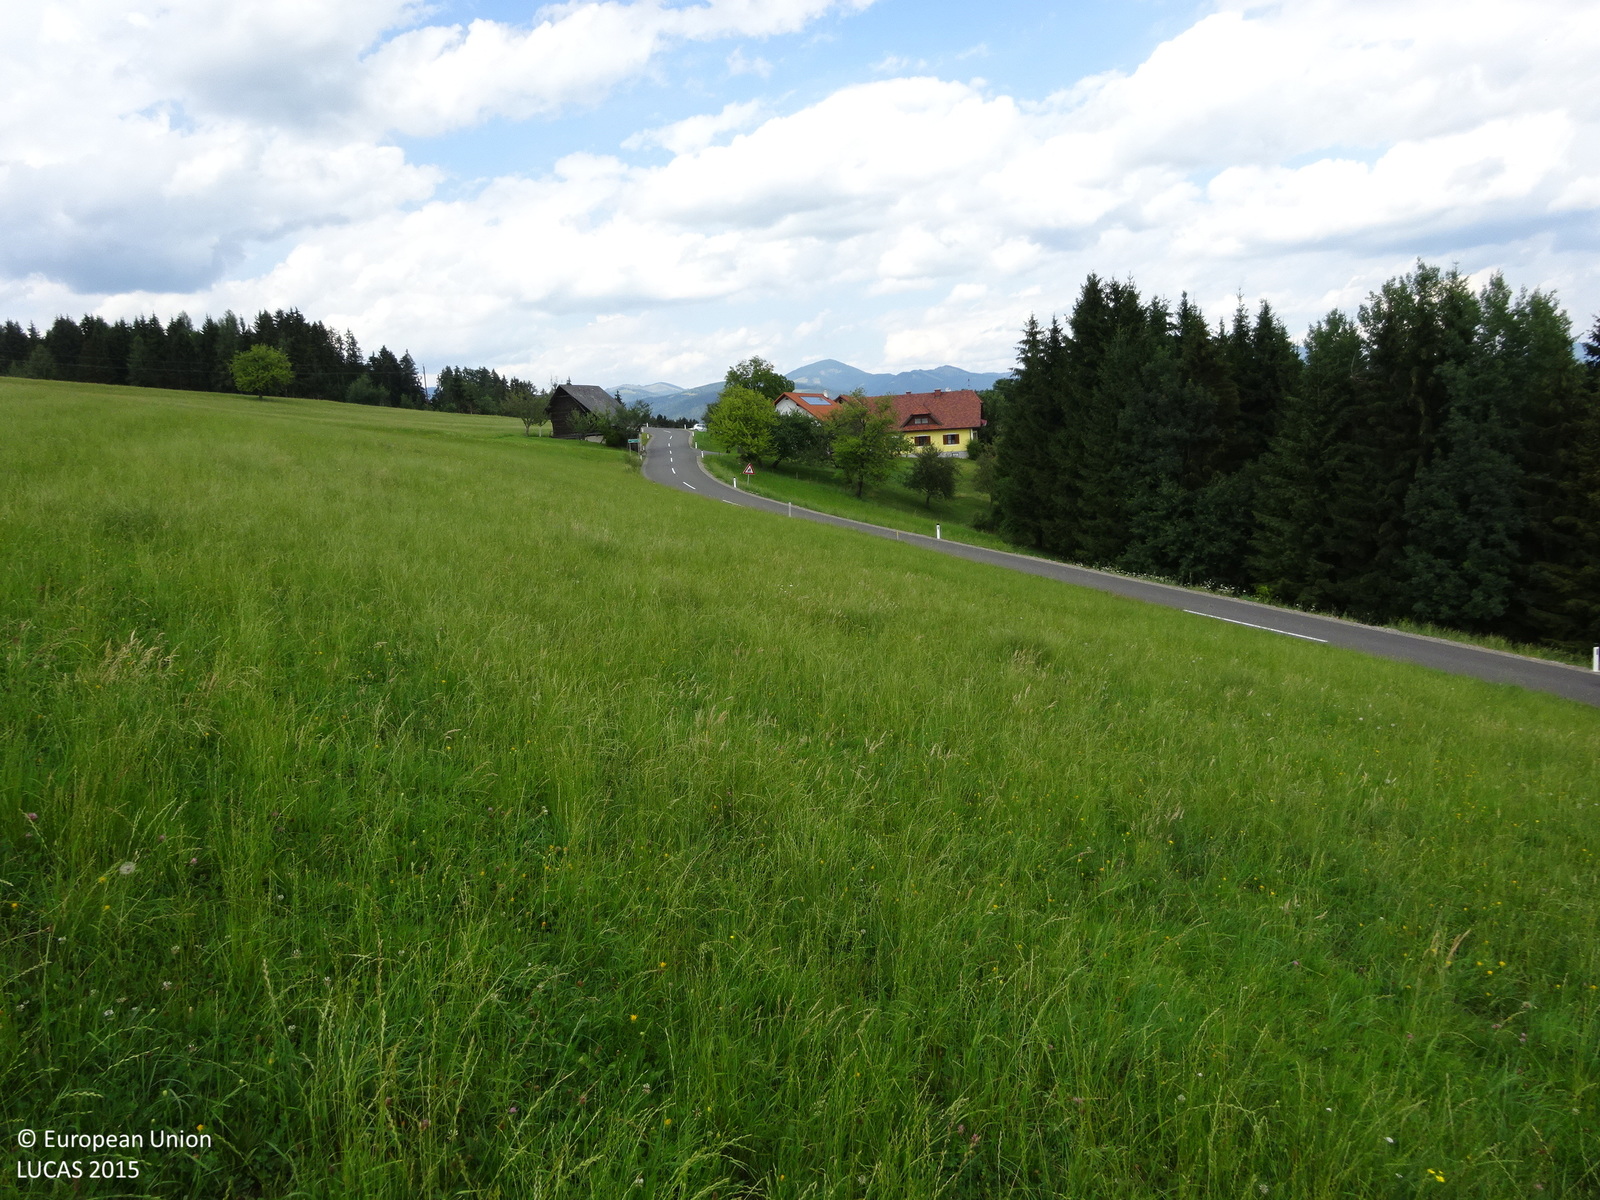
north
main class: Grassland
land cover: Grassland without tree/shrub cover
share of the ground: > 75 %
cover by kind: herbaceous plants 100 %
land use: Agriculture (excluding fallow land and kitchen gardens)
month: July
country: AT
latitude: 47.2406
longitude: 15.4562
